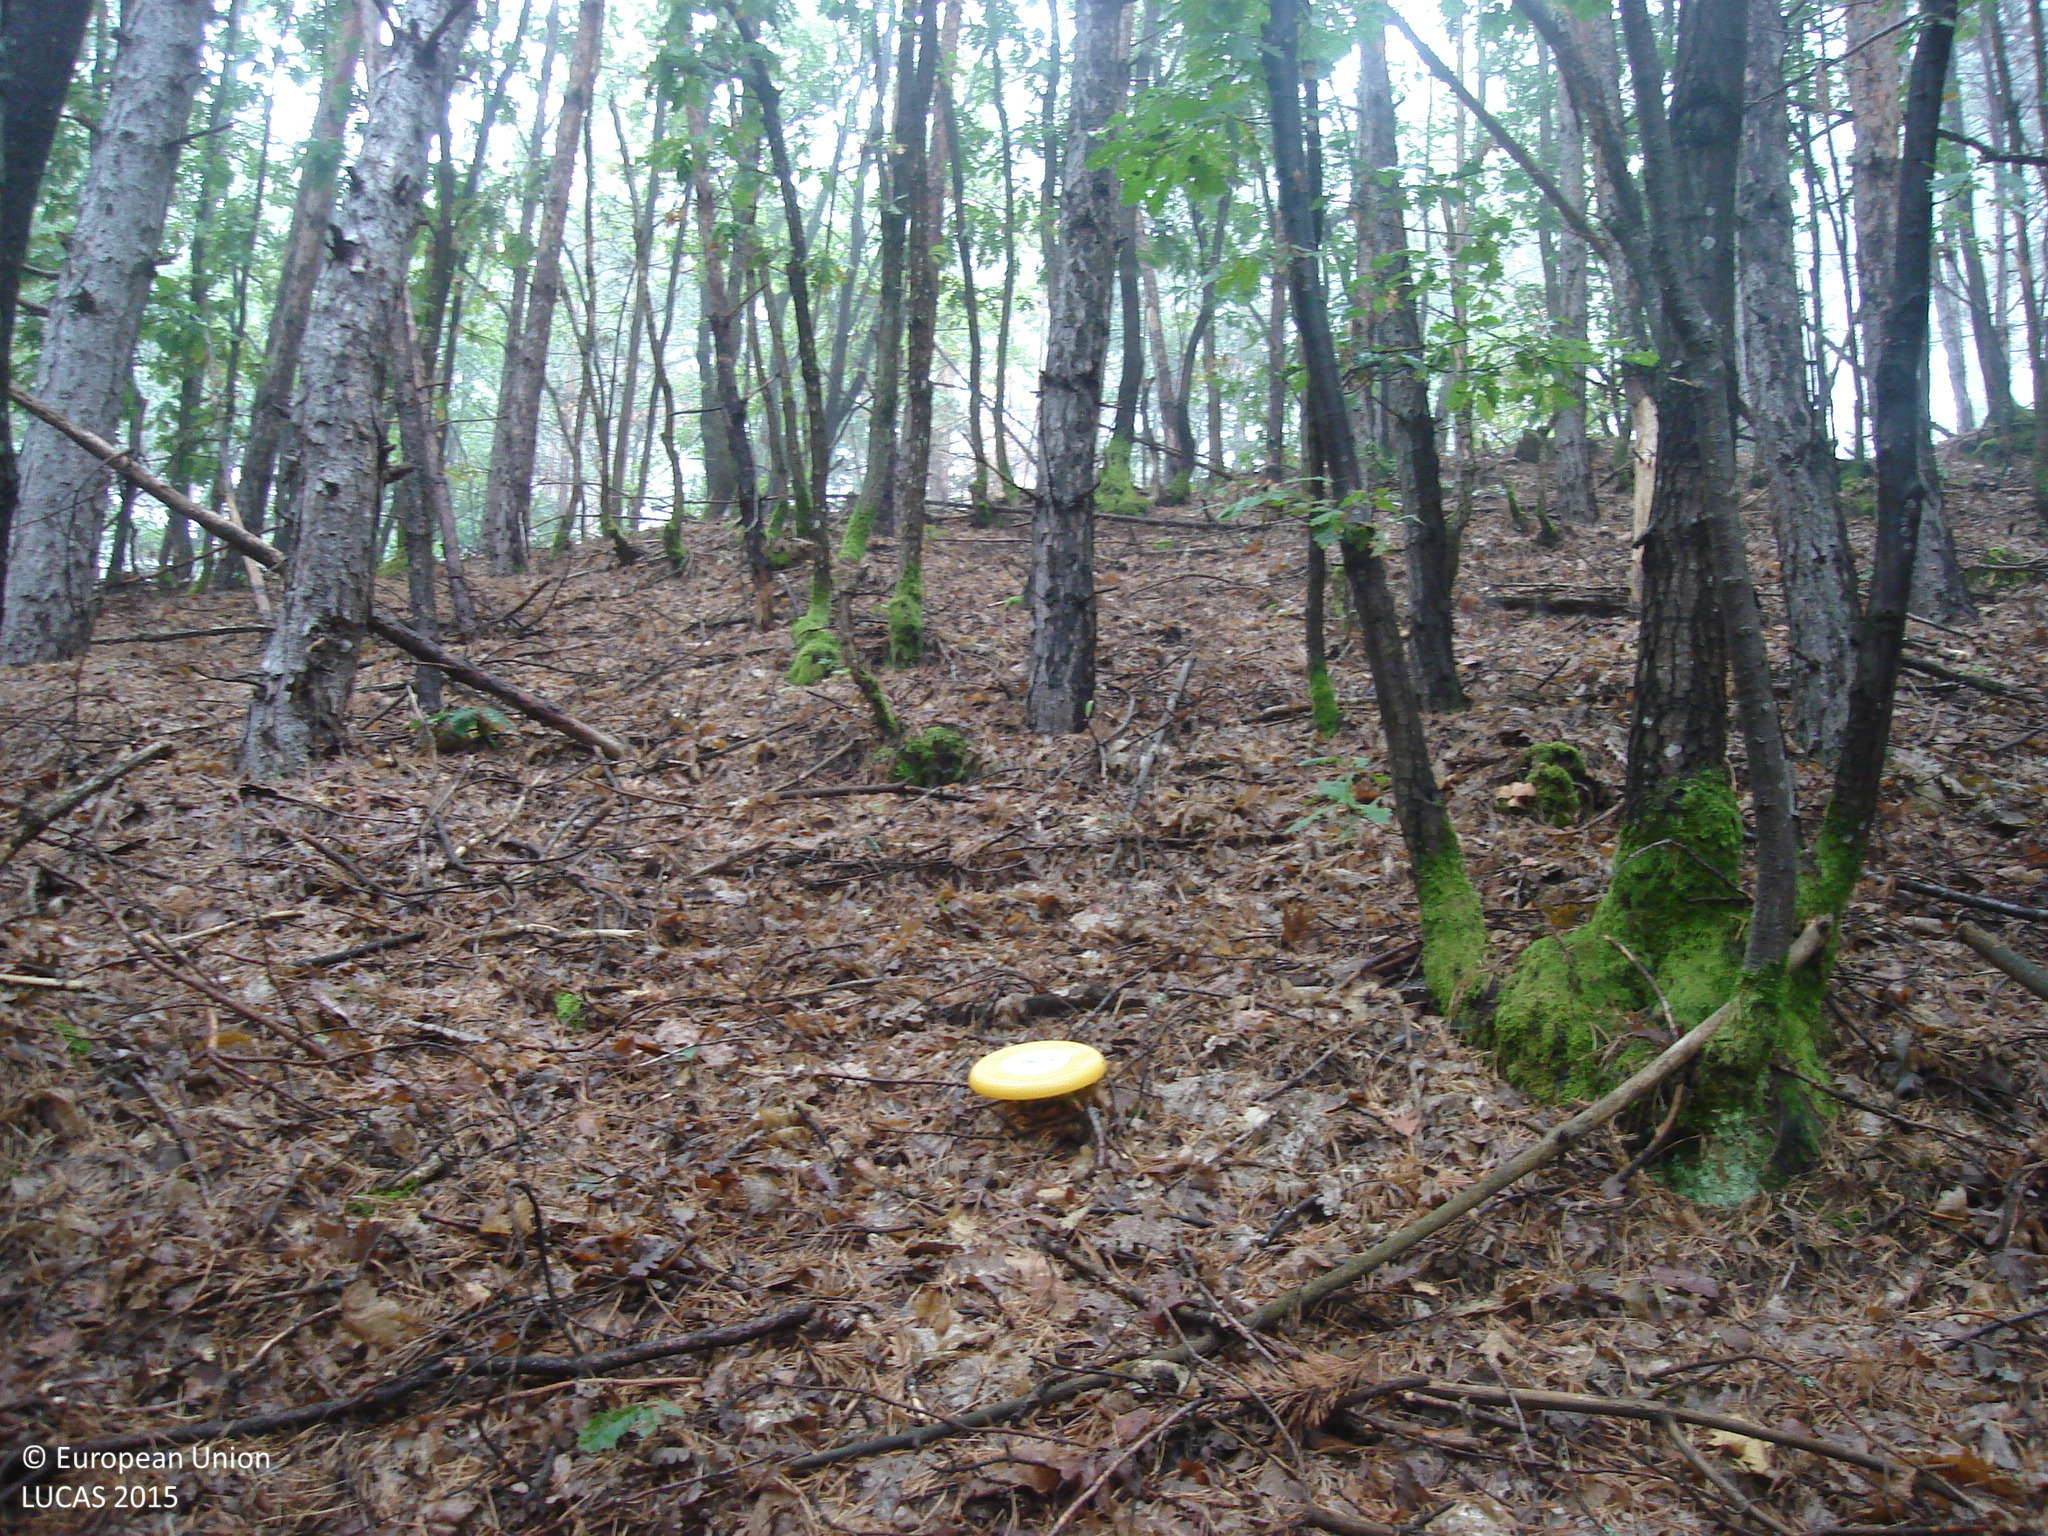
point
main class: Woodland
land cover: Pine dominated mixed woodland
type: hemiboreal forest and nemoral coniferous forest and mixed broadleaved-coniferous forest
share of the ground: > 75 %
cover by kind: coniferous forest trees 50 %, broadleaved forest trees 30 %, unconsolidated bare surface 15 %, herbaceous plants 5 %
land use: Forestry
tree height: > 5 m
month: September
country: BG
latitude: 42.9923
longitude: 23.1959
